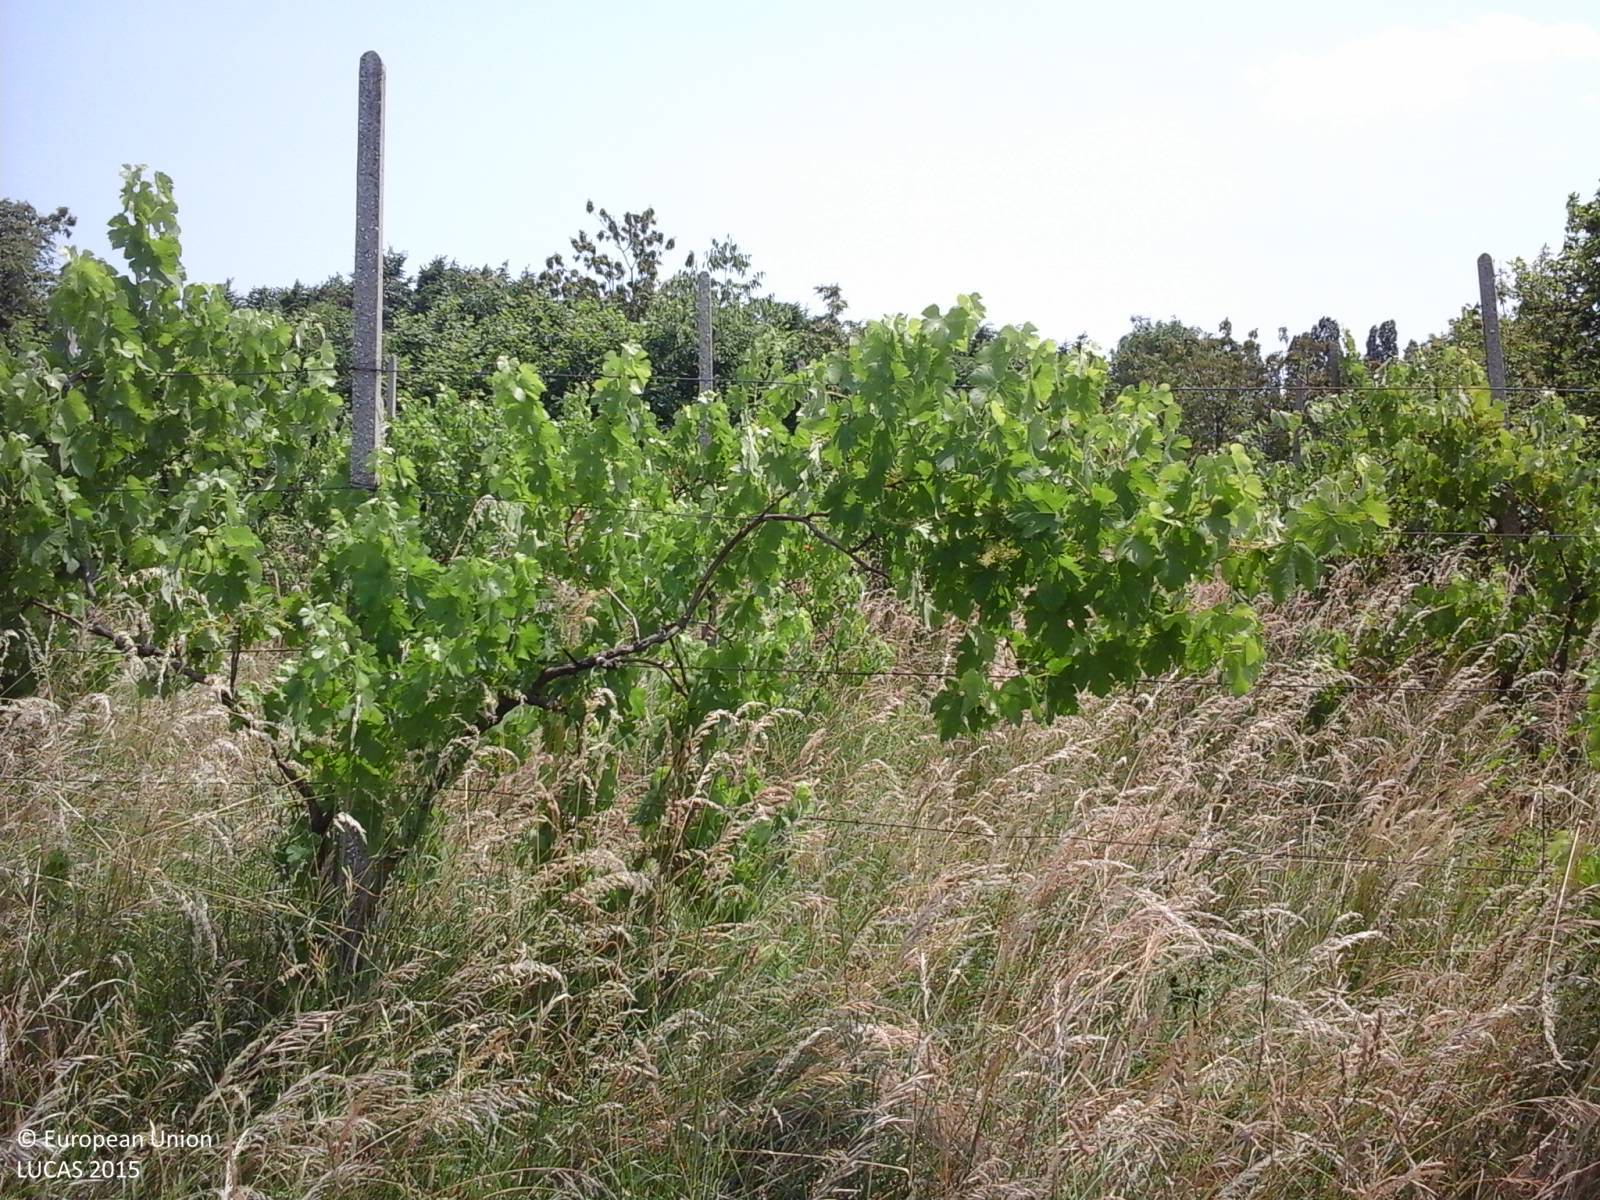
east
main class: Cropland
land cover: Vineyards
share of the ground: > 75 %
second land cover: Grassland without tree/shrub cover
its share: > 75 %
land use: Agriculture (excluding fallow land and kitchen gardens)
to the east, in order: Vineyards; Grassland without tree/shrub cover; Abandoned hedges; Grassland without tree/shrub cover; Abandoned hedges; Grassland without tree/shrub cover; Abandoned hedges; Grassland without tree/shrub cover; Lines of trees; Paved roads, cycling and walking lanes; Grass margins; Fences; Managed hedges; Other fruit trees and berries; Apple fruit; Fences; Grass margins; Tracks; Grassland without tree/shrub cover
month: June
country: IT
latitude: 46.0507
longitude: 12.5429
